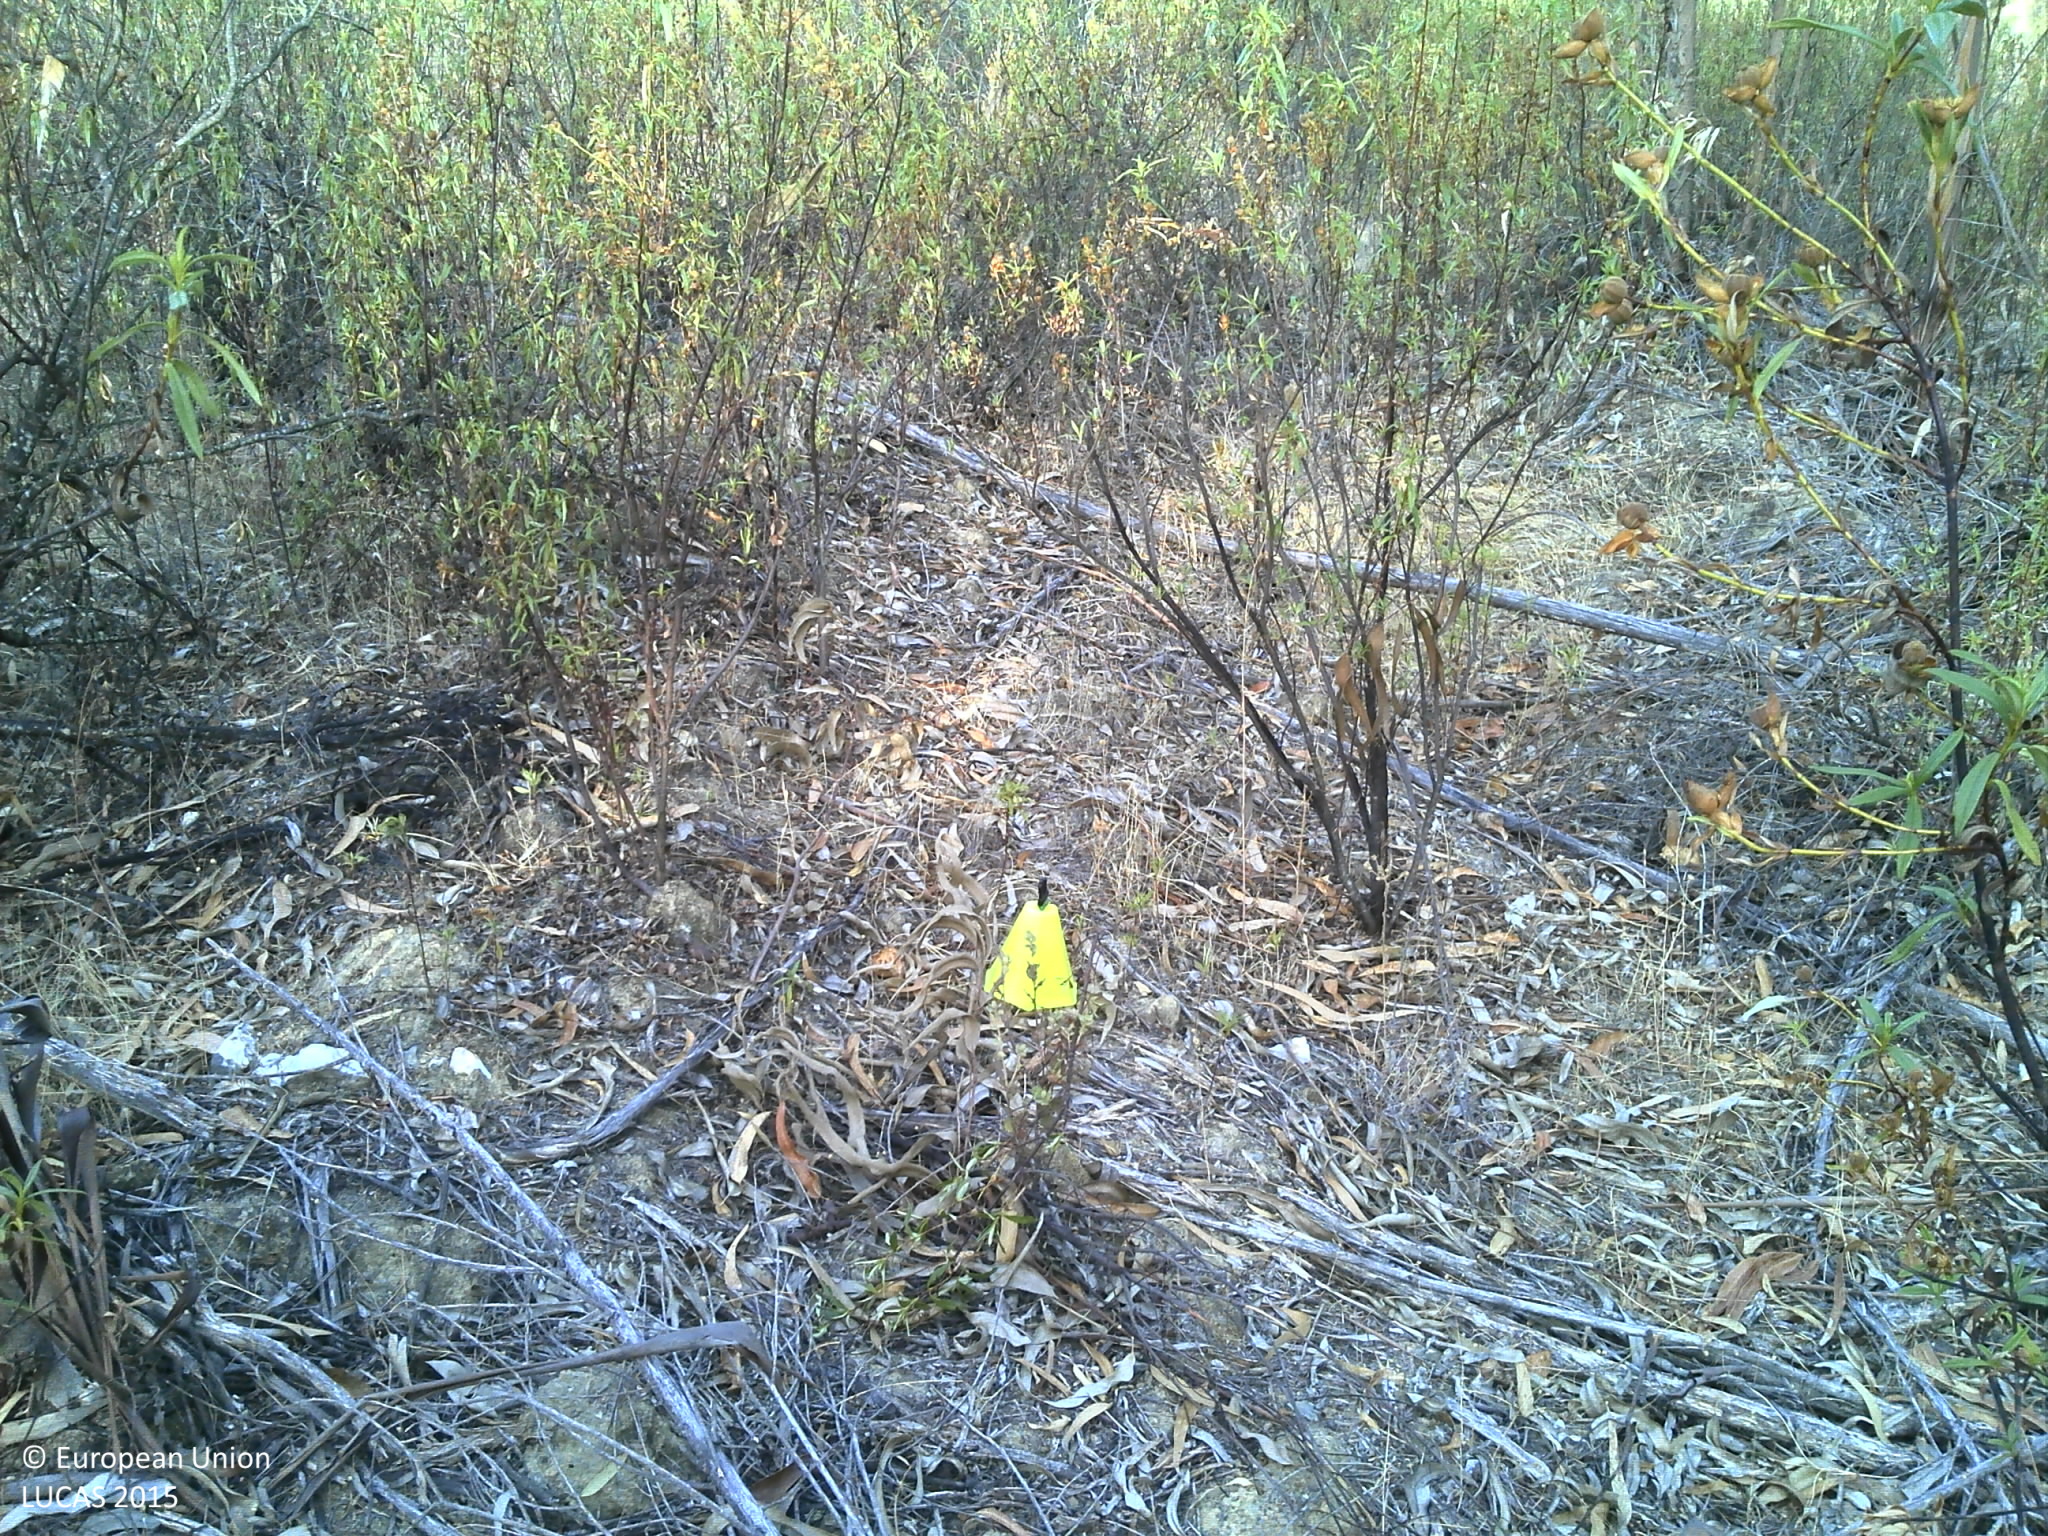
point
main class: Woodland
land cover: Broadleaved woodland
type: exotic forest
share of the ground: 25 - 50 %
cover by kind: shrubs 50 %, broadleaved forest trees 40 %, unconsolidated bare surface 10 %
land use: Forestry
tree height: > 5 m
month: July
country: PT
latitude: 38.6549
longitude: -7.4390
